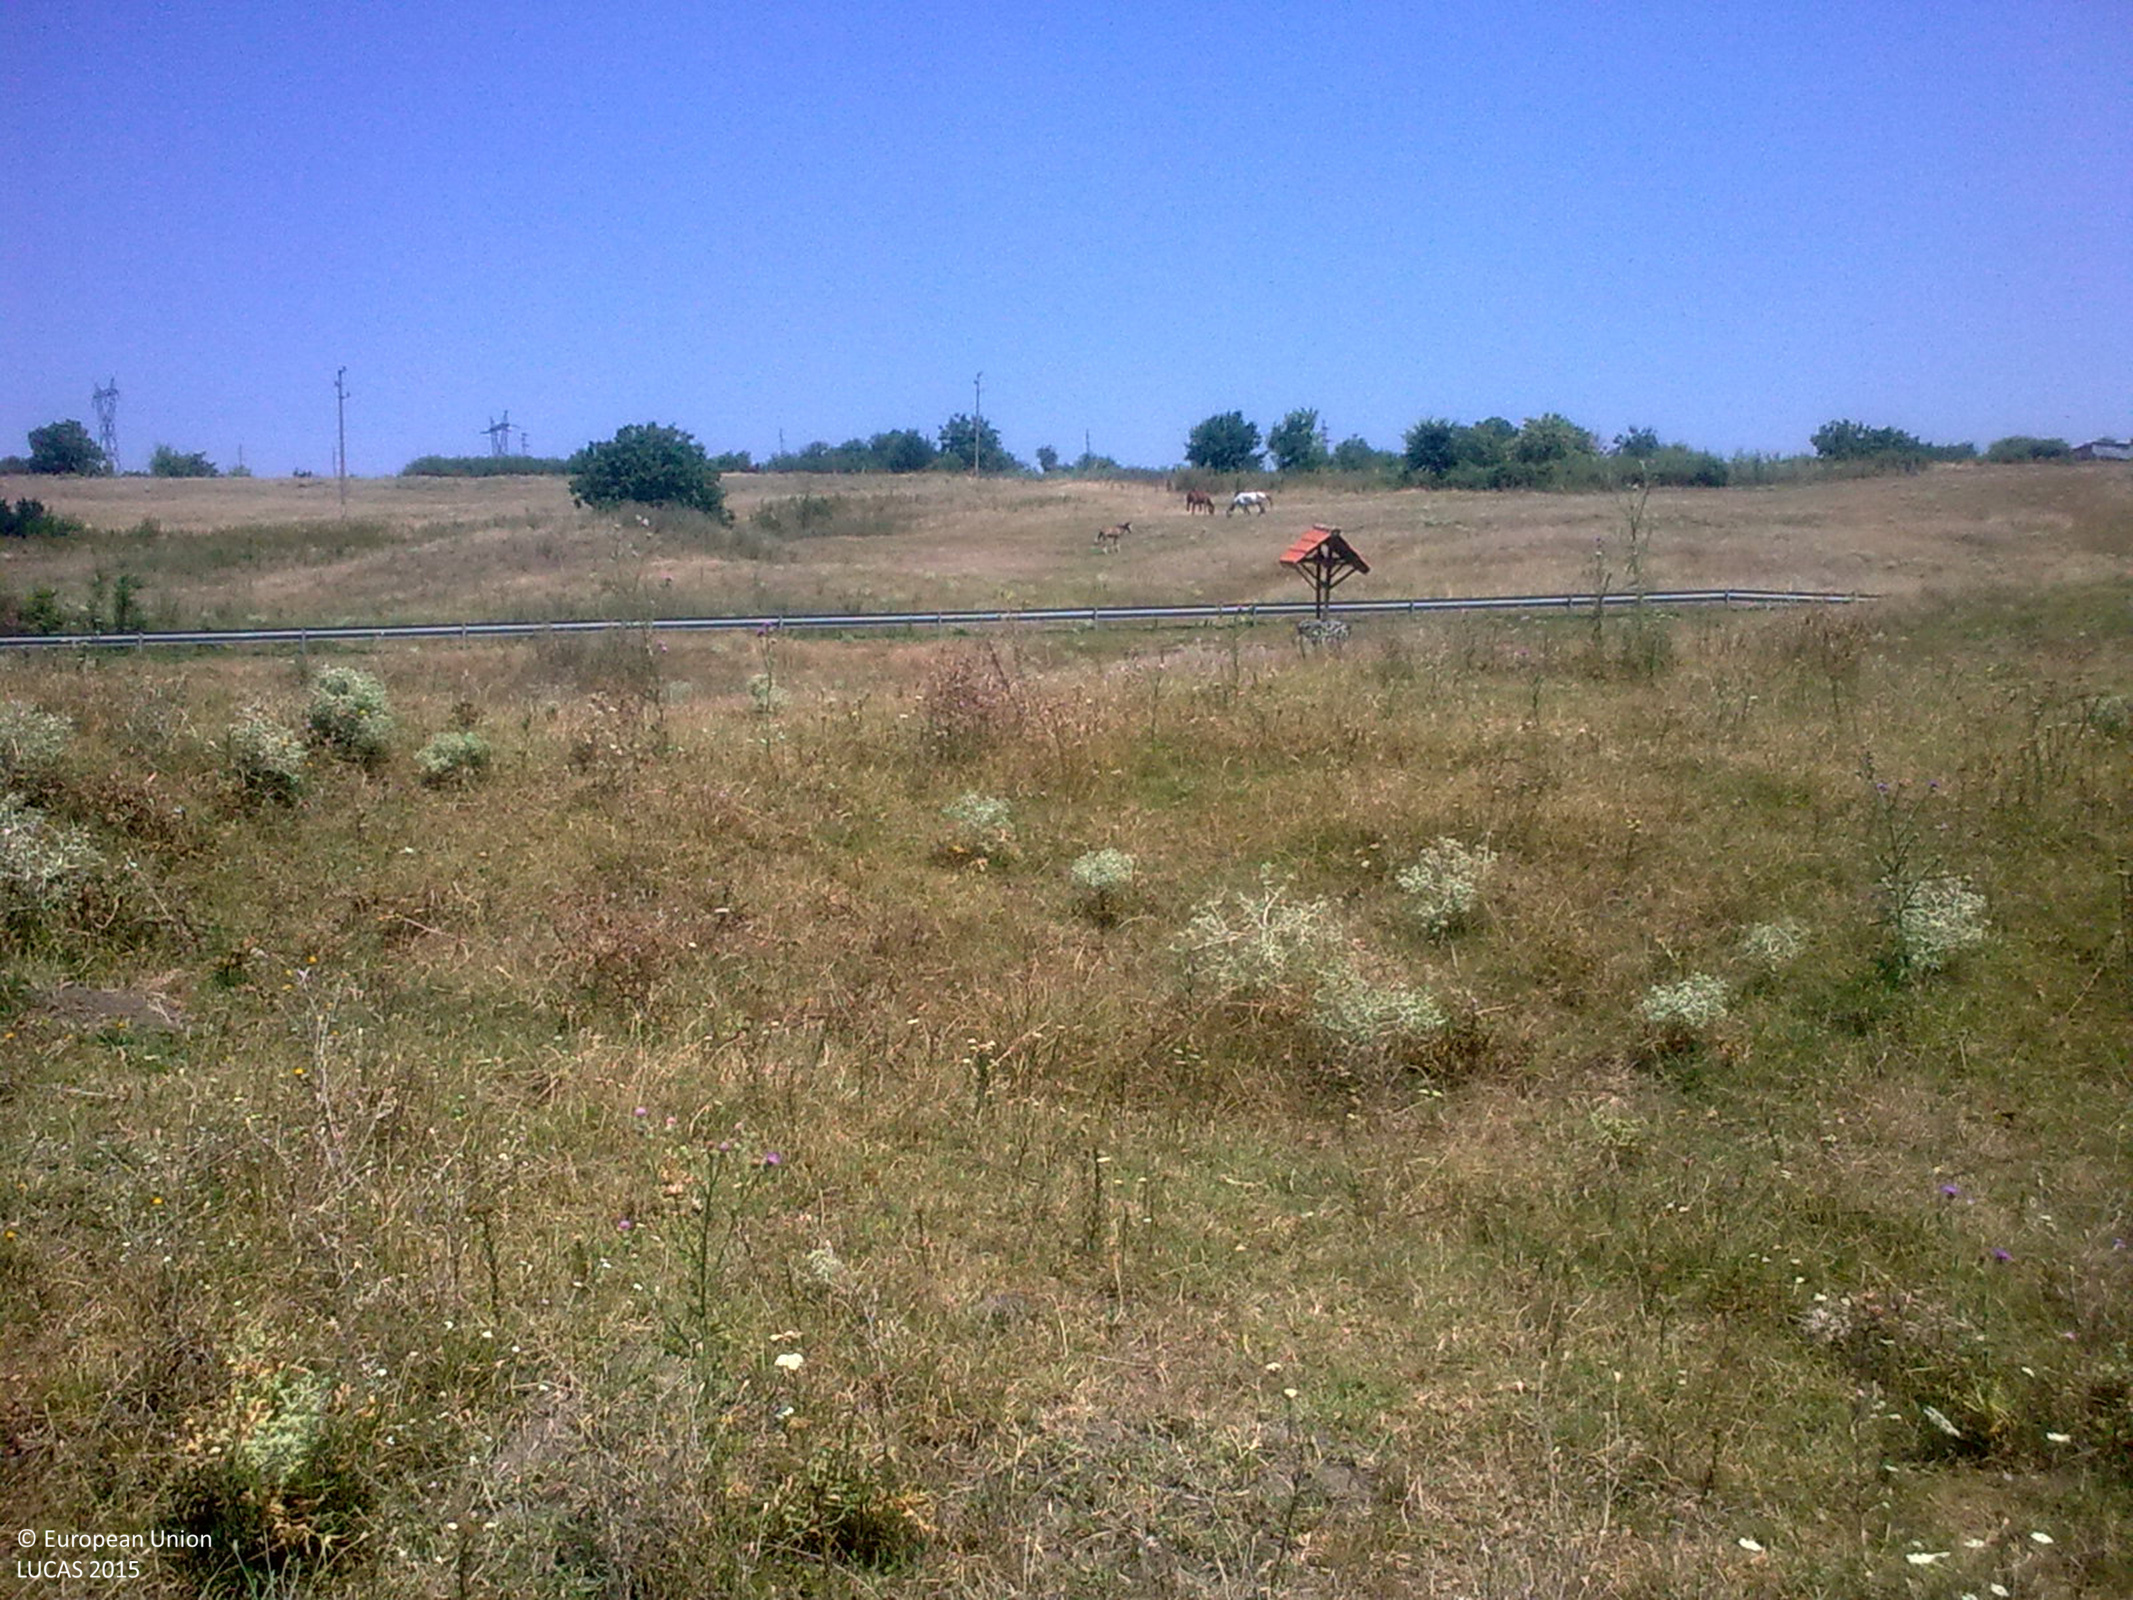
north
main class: Grassland
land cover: Grassland without tree/shrub cover
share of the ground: > 75 %
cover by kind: herbaceous plants 100 %
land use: Agriculture (excluding fallow land and kitchen gardens)
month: July
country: BG
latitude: 43.8630
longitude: 26.1635
